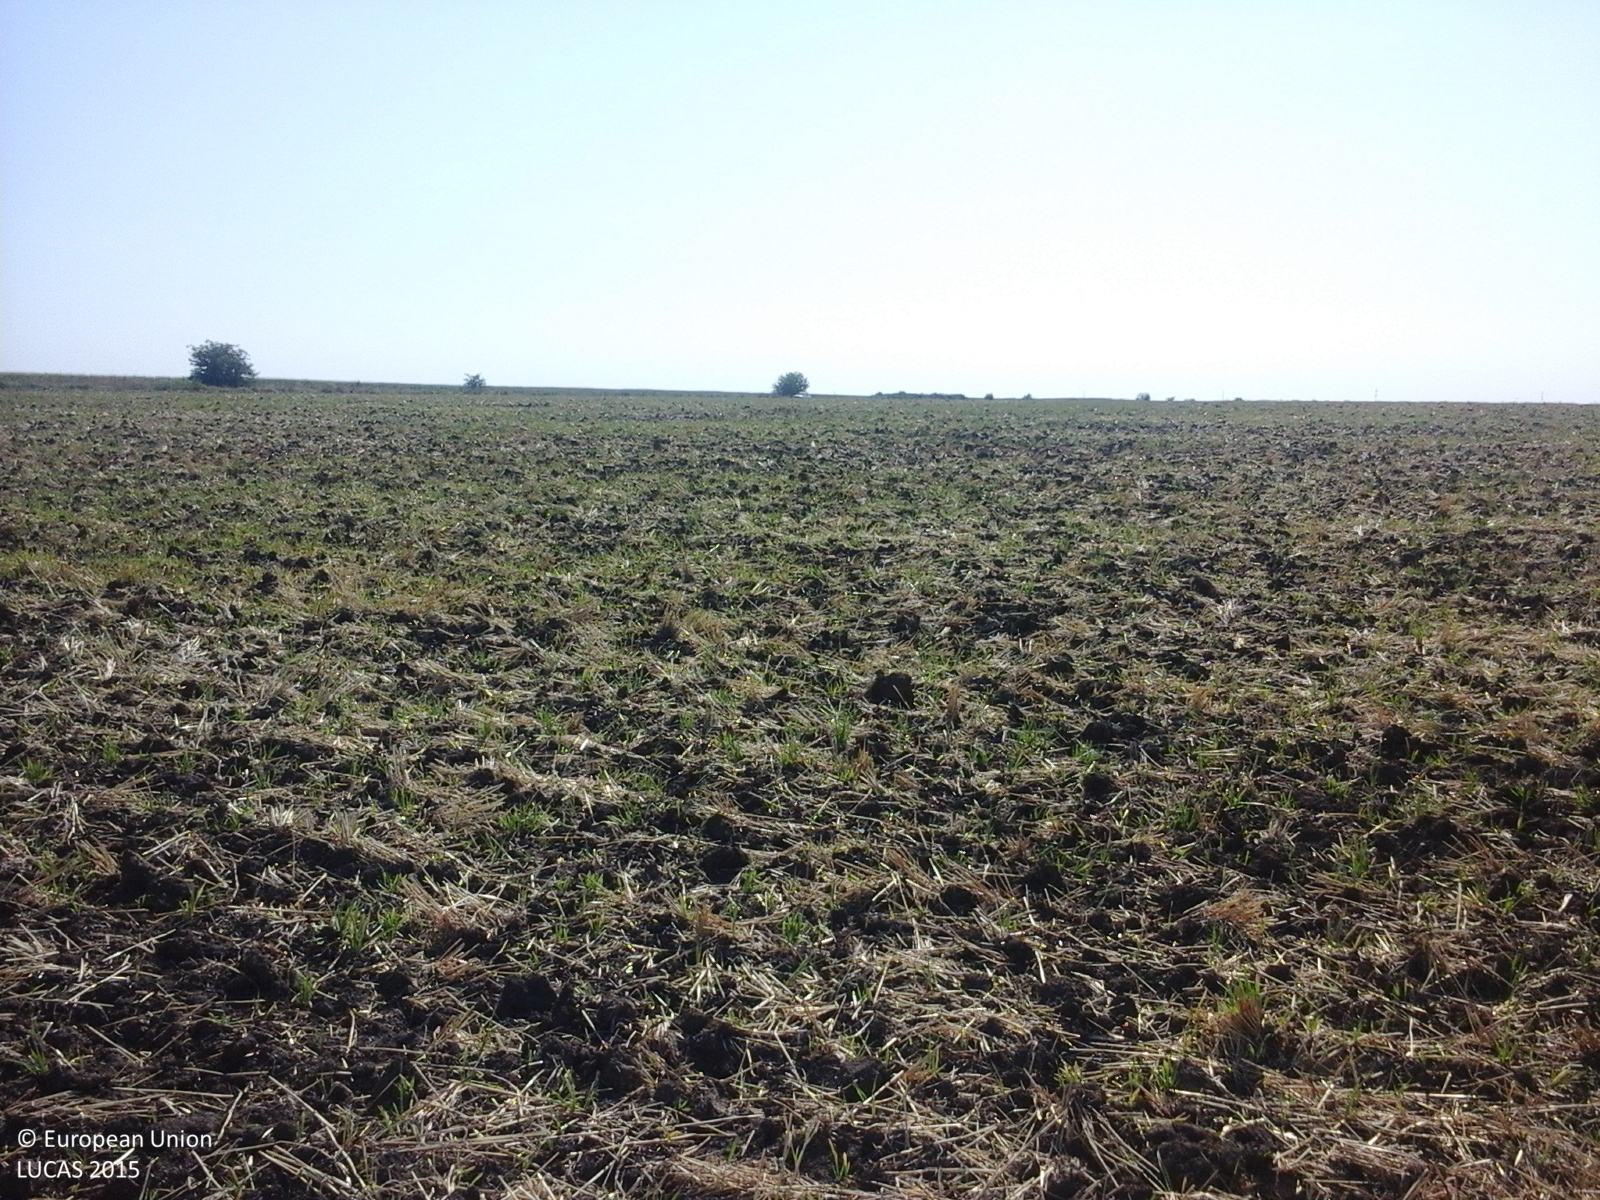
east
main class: Cropland
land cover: Common wheat
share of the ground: 10 - 25 %
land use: Agriculture (excluding fallow land and kitchen gardens)
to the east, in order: Common wheat
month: July
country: RO
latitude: 44.3922
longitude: 27.0904
